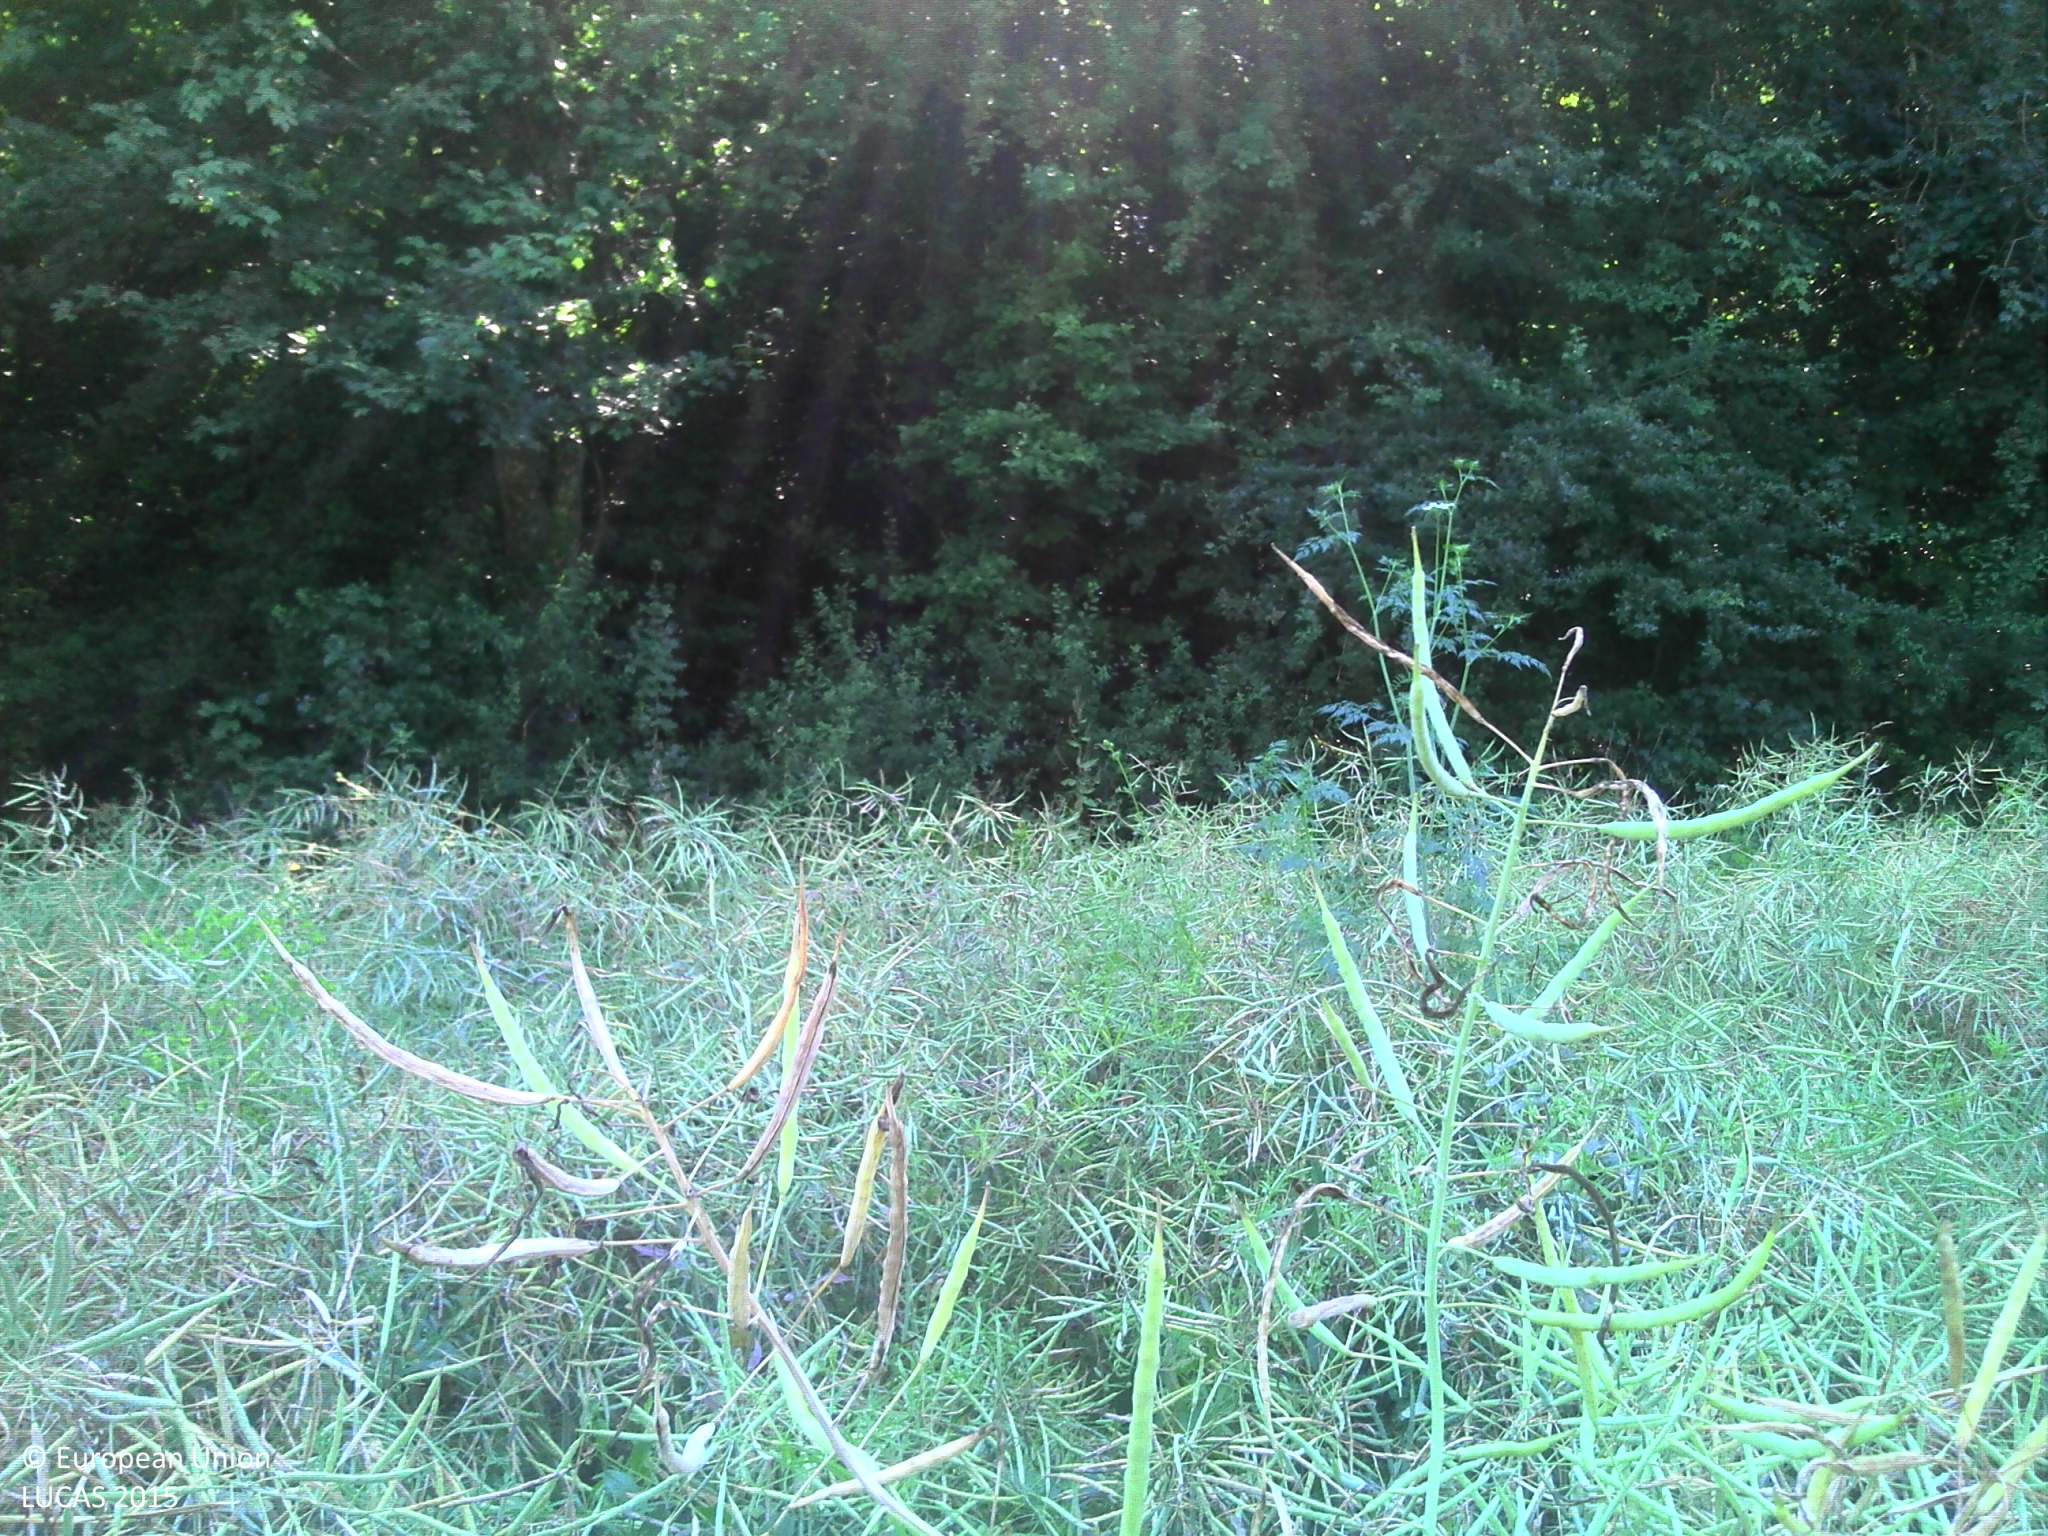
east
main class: Cropland
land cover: Rape and turnip rape
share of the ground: > 75 %
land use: Agriculture (excluding fallow land and kitchen gardens)
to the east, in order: Rape and turnip rape; Broadleaved woodland; Common wheat
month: June
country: FR
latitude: 48.6936
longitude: 5.1484
